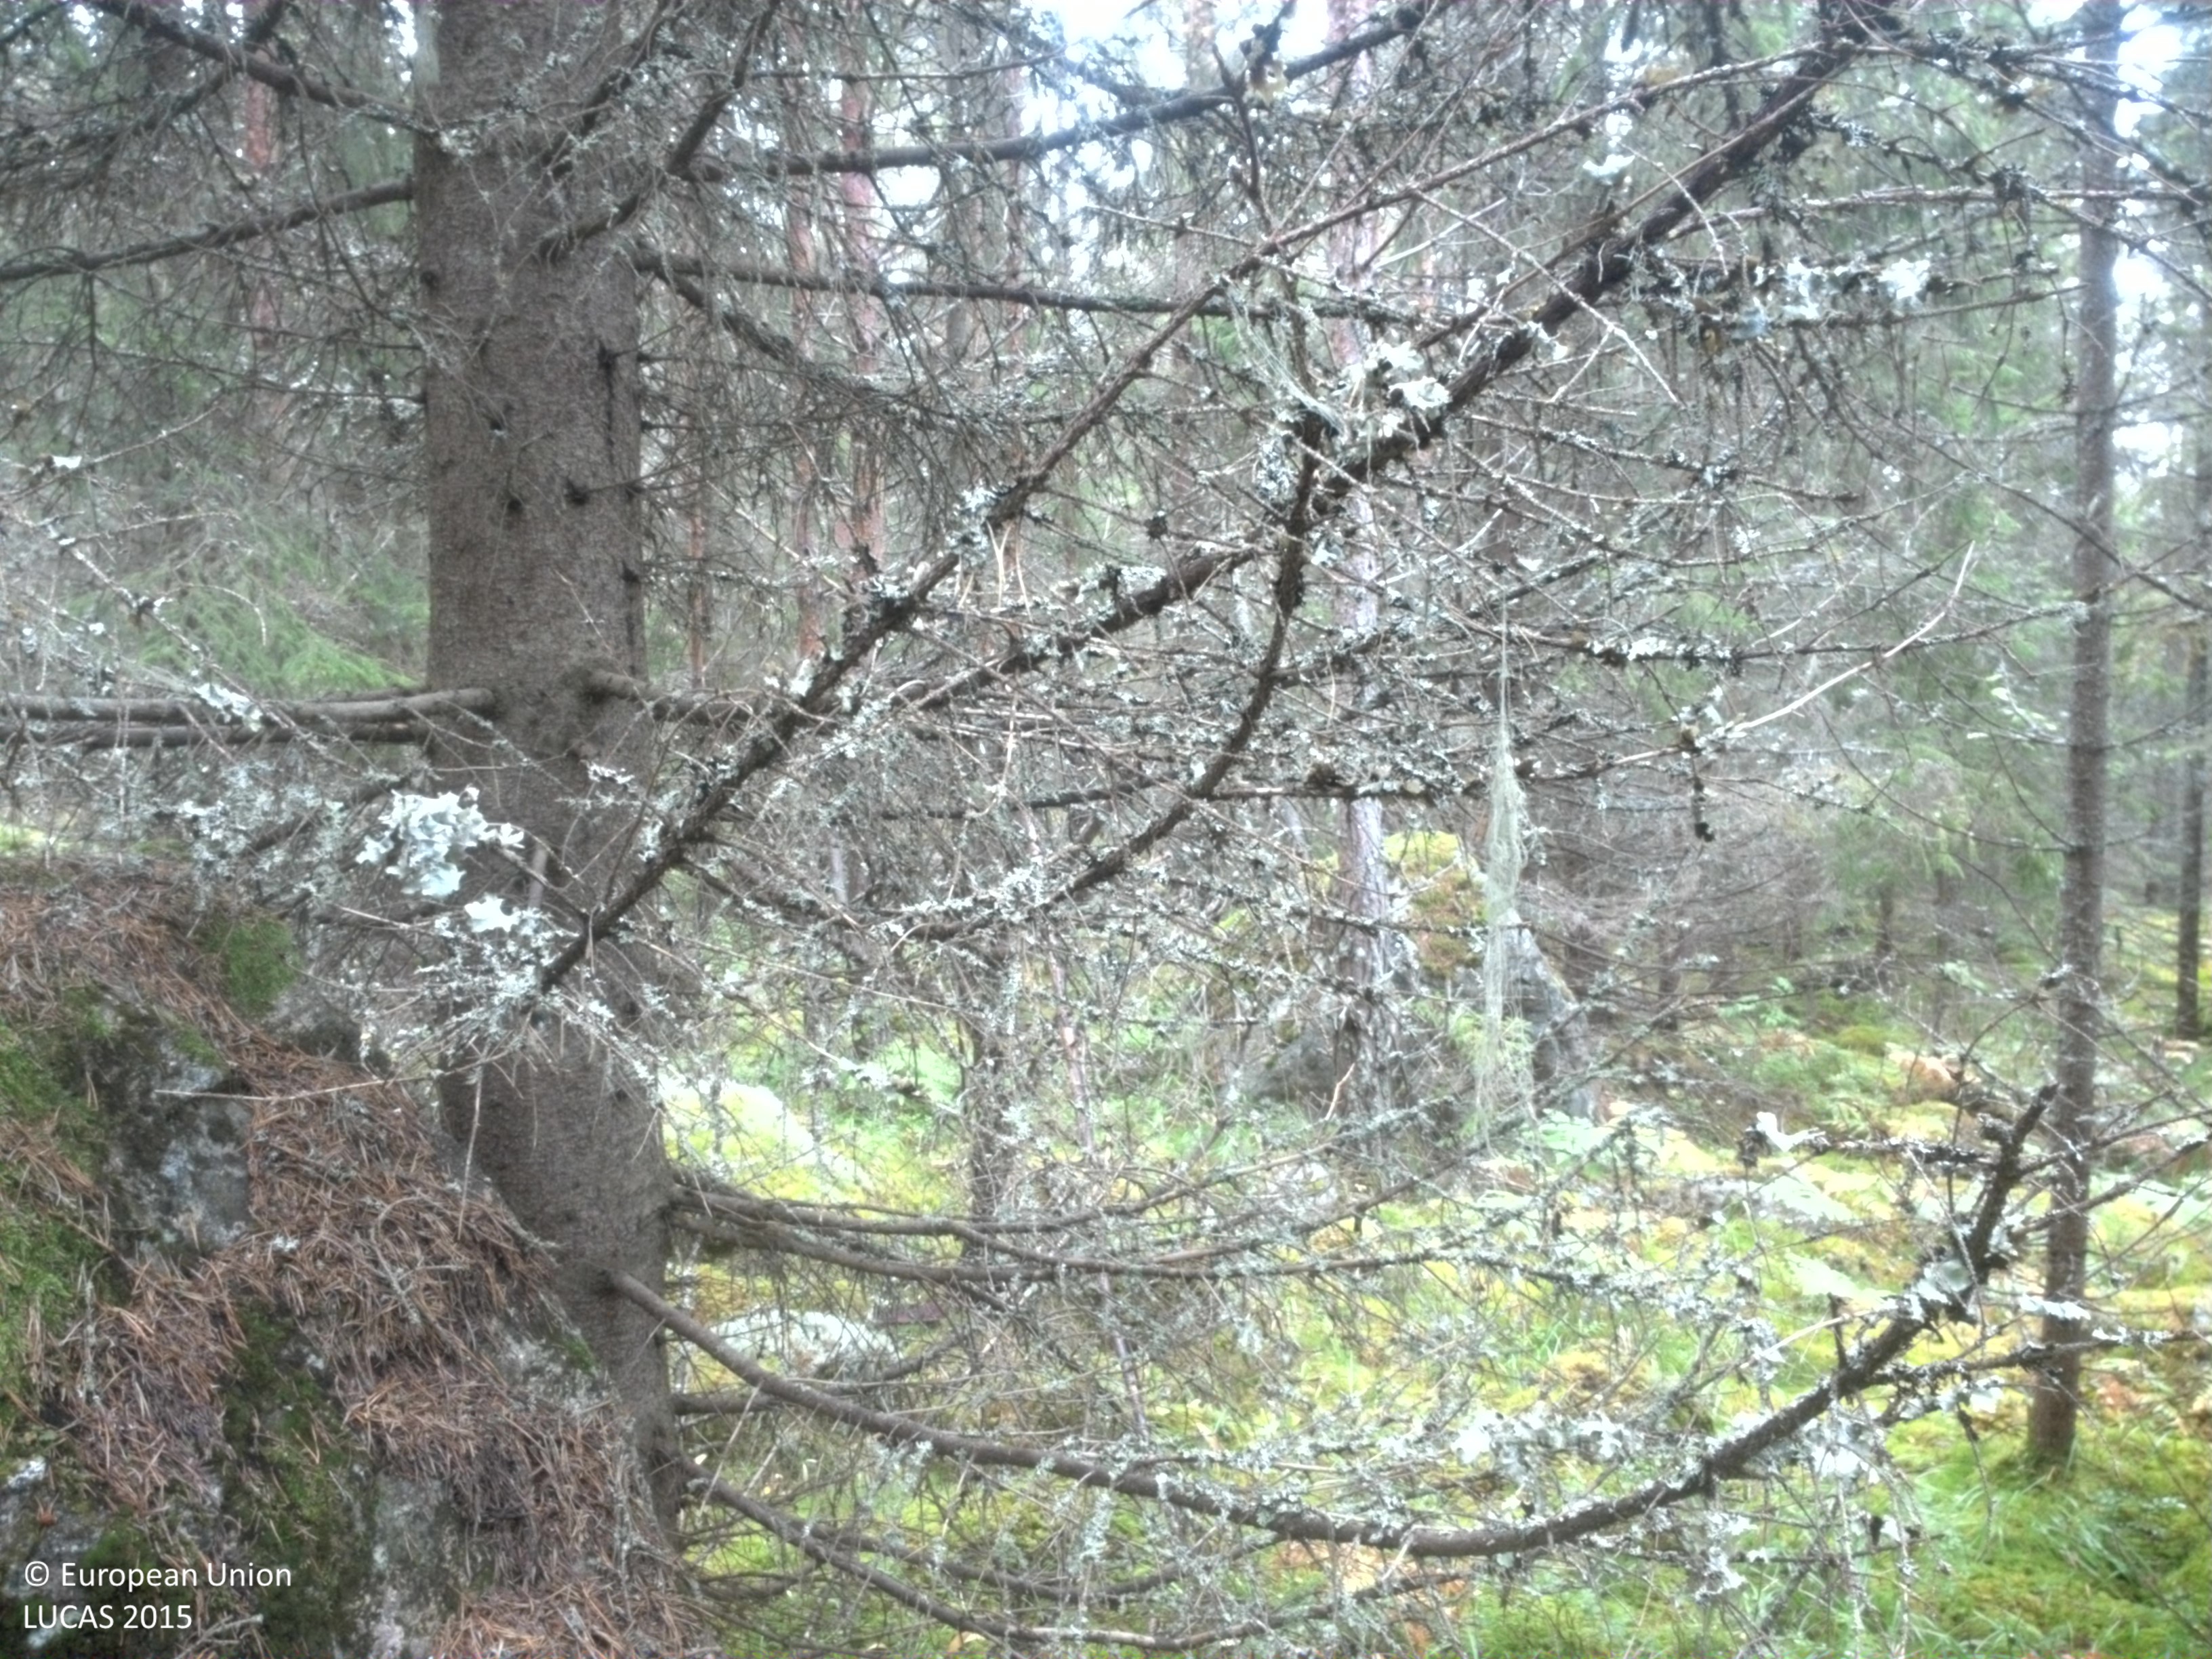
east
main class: Woodland
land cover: Other coniferous woodland
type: boreal forest
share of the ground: > 75 %
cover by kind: coniferous forest trees 75 %, lichens and mosses 15 %, shrubs 10 %
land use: Forestry
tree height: > 5 m
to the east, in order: Other coniferous woodland; Rock outcrops; Other coniferous woodland; Rock outcrops; Other coniferous woodland
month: September
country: SE
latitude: 59.6523
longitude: 15.6512
